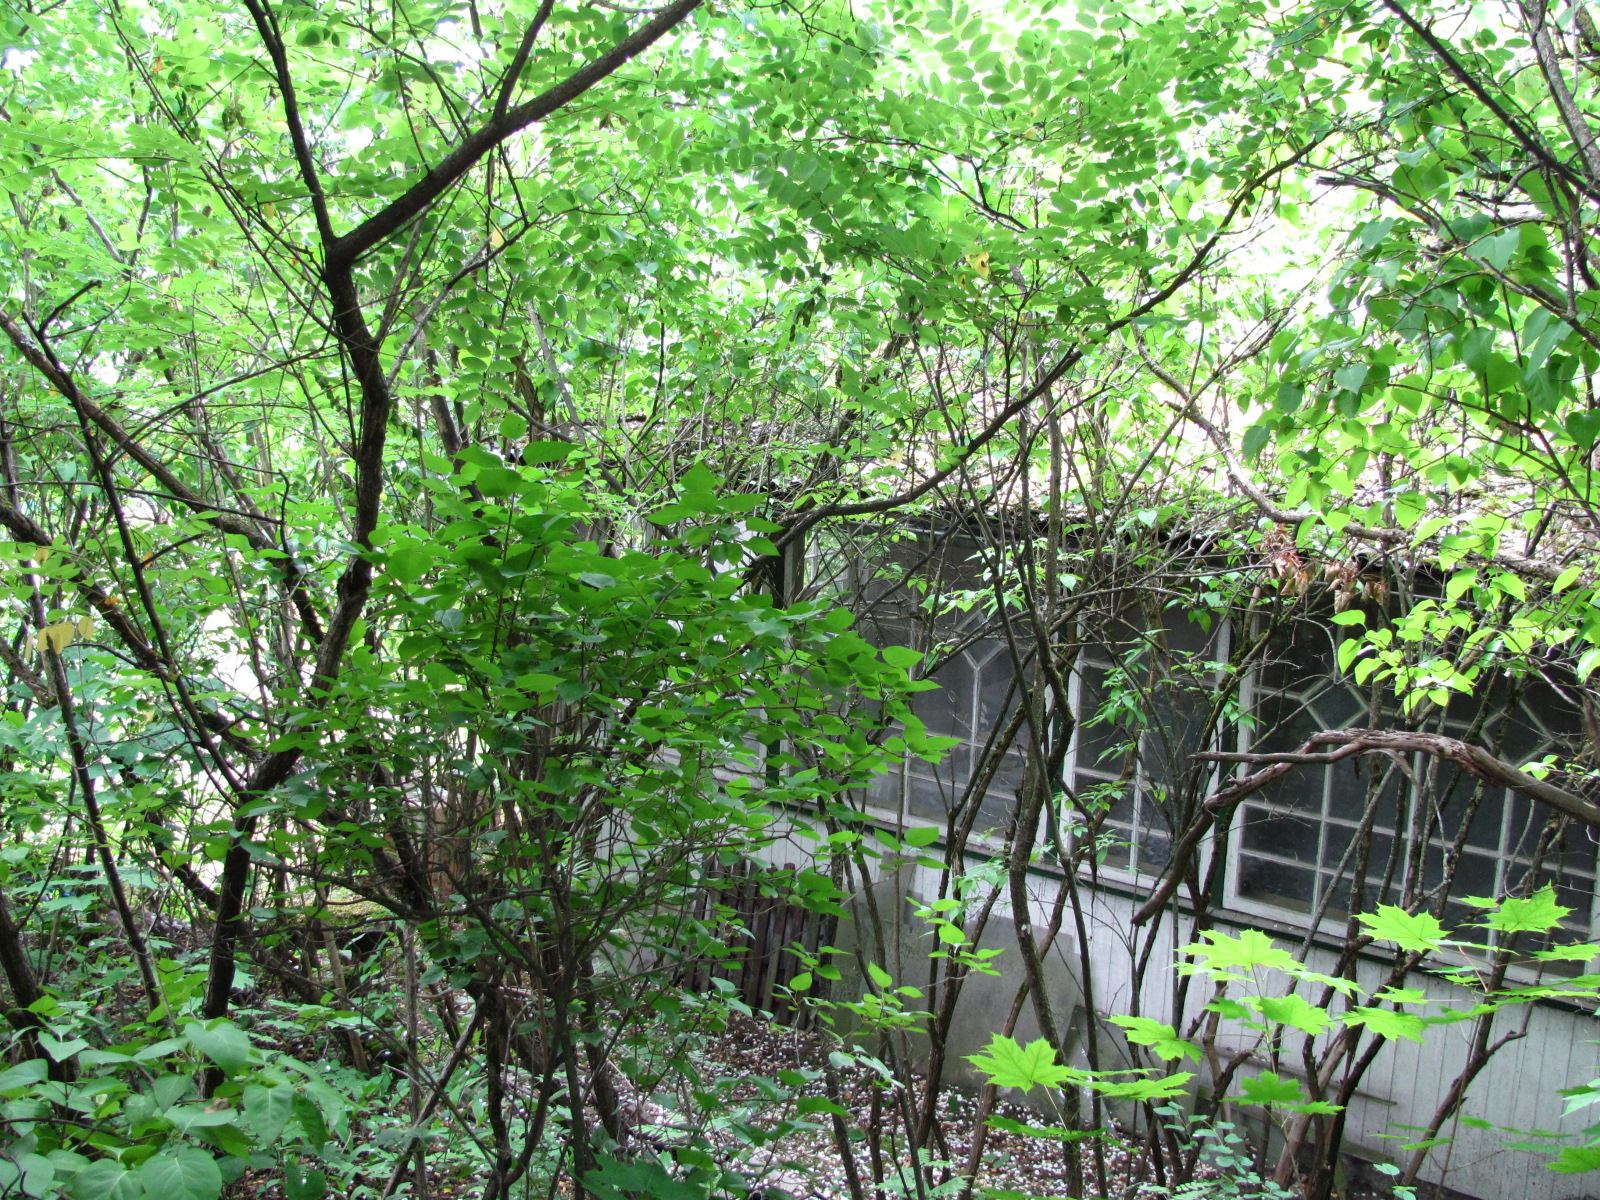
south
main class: Woodland
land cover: Broadleaved woodland
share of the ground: > 75 %
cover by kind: broadleaved forest trees 100 %
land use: Residential
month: July
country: LV
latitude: 57.0415
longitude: 24.1776
